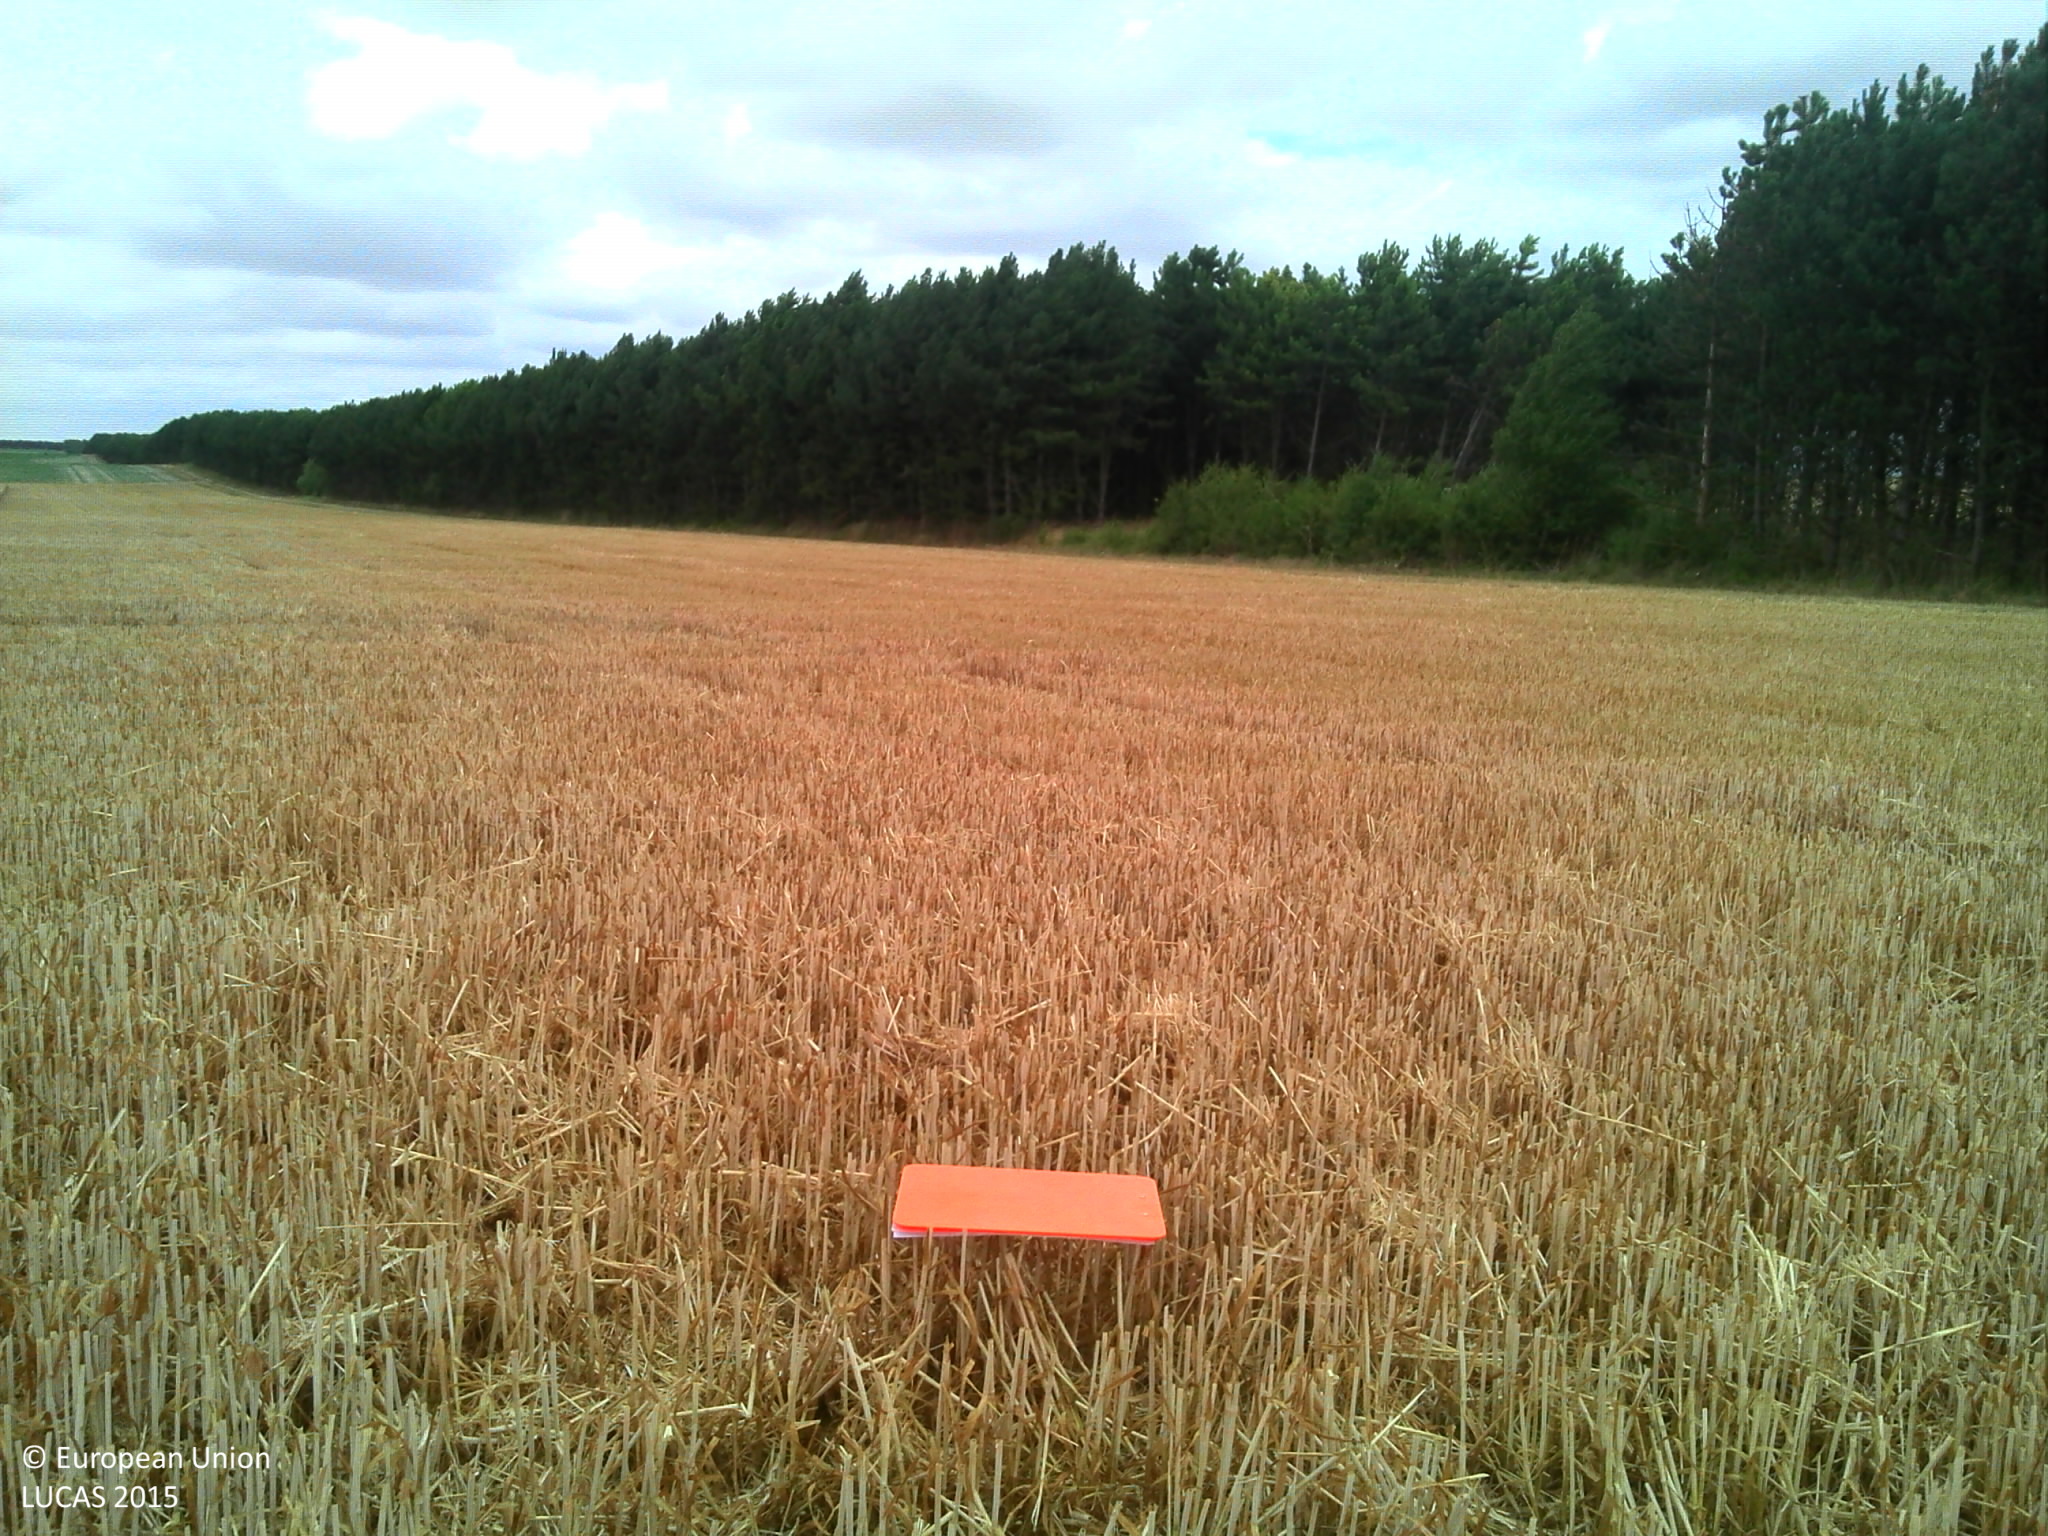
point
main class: Cropland
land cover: Common wheat
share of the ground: > 75 %
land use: Agriculture (excluding fallow land and kitchen gardens)
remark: Harvested field
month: July
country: FR
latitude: 48.7915
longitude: 4.1836
